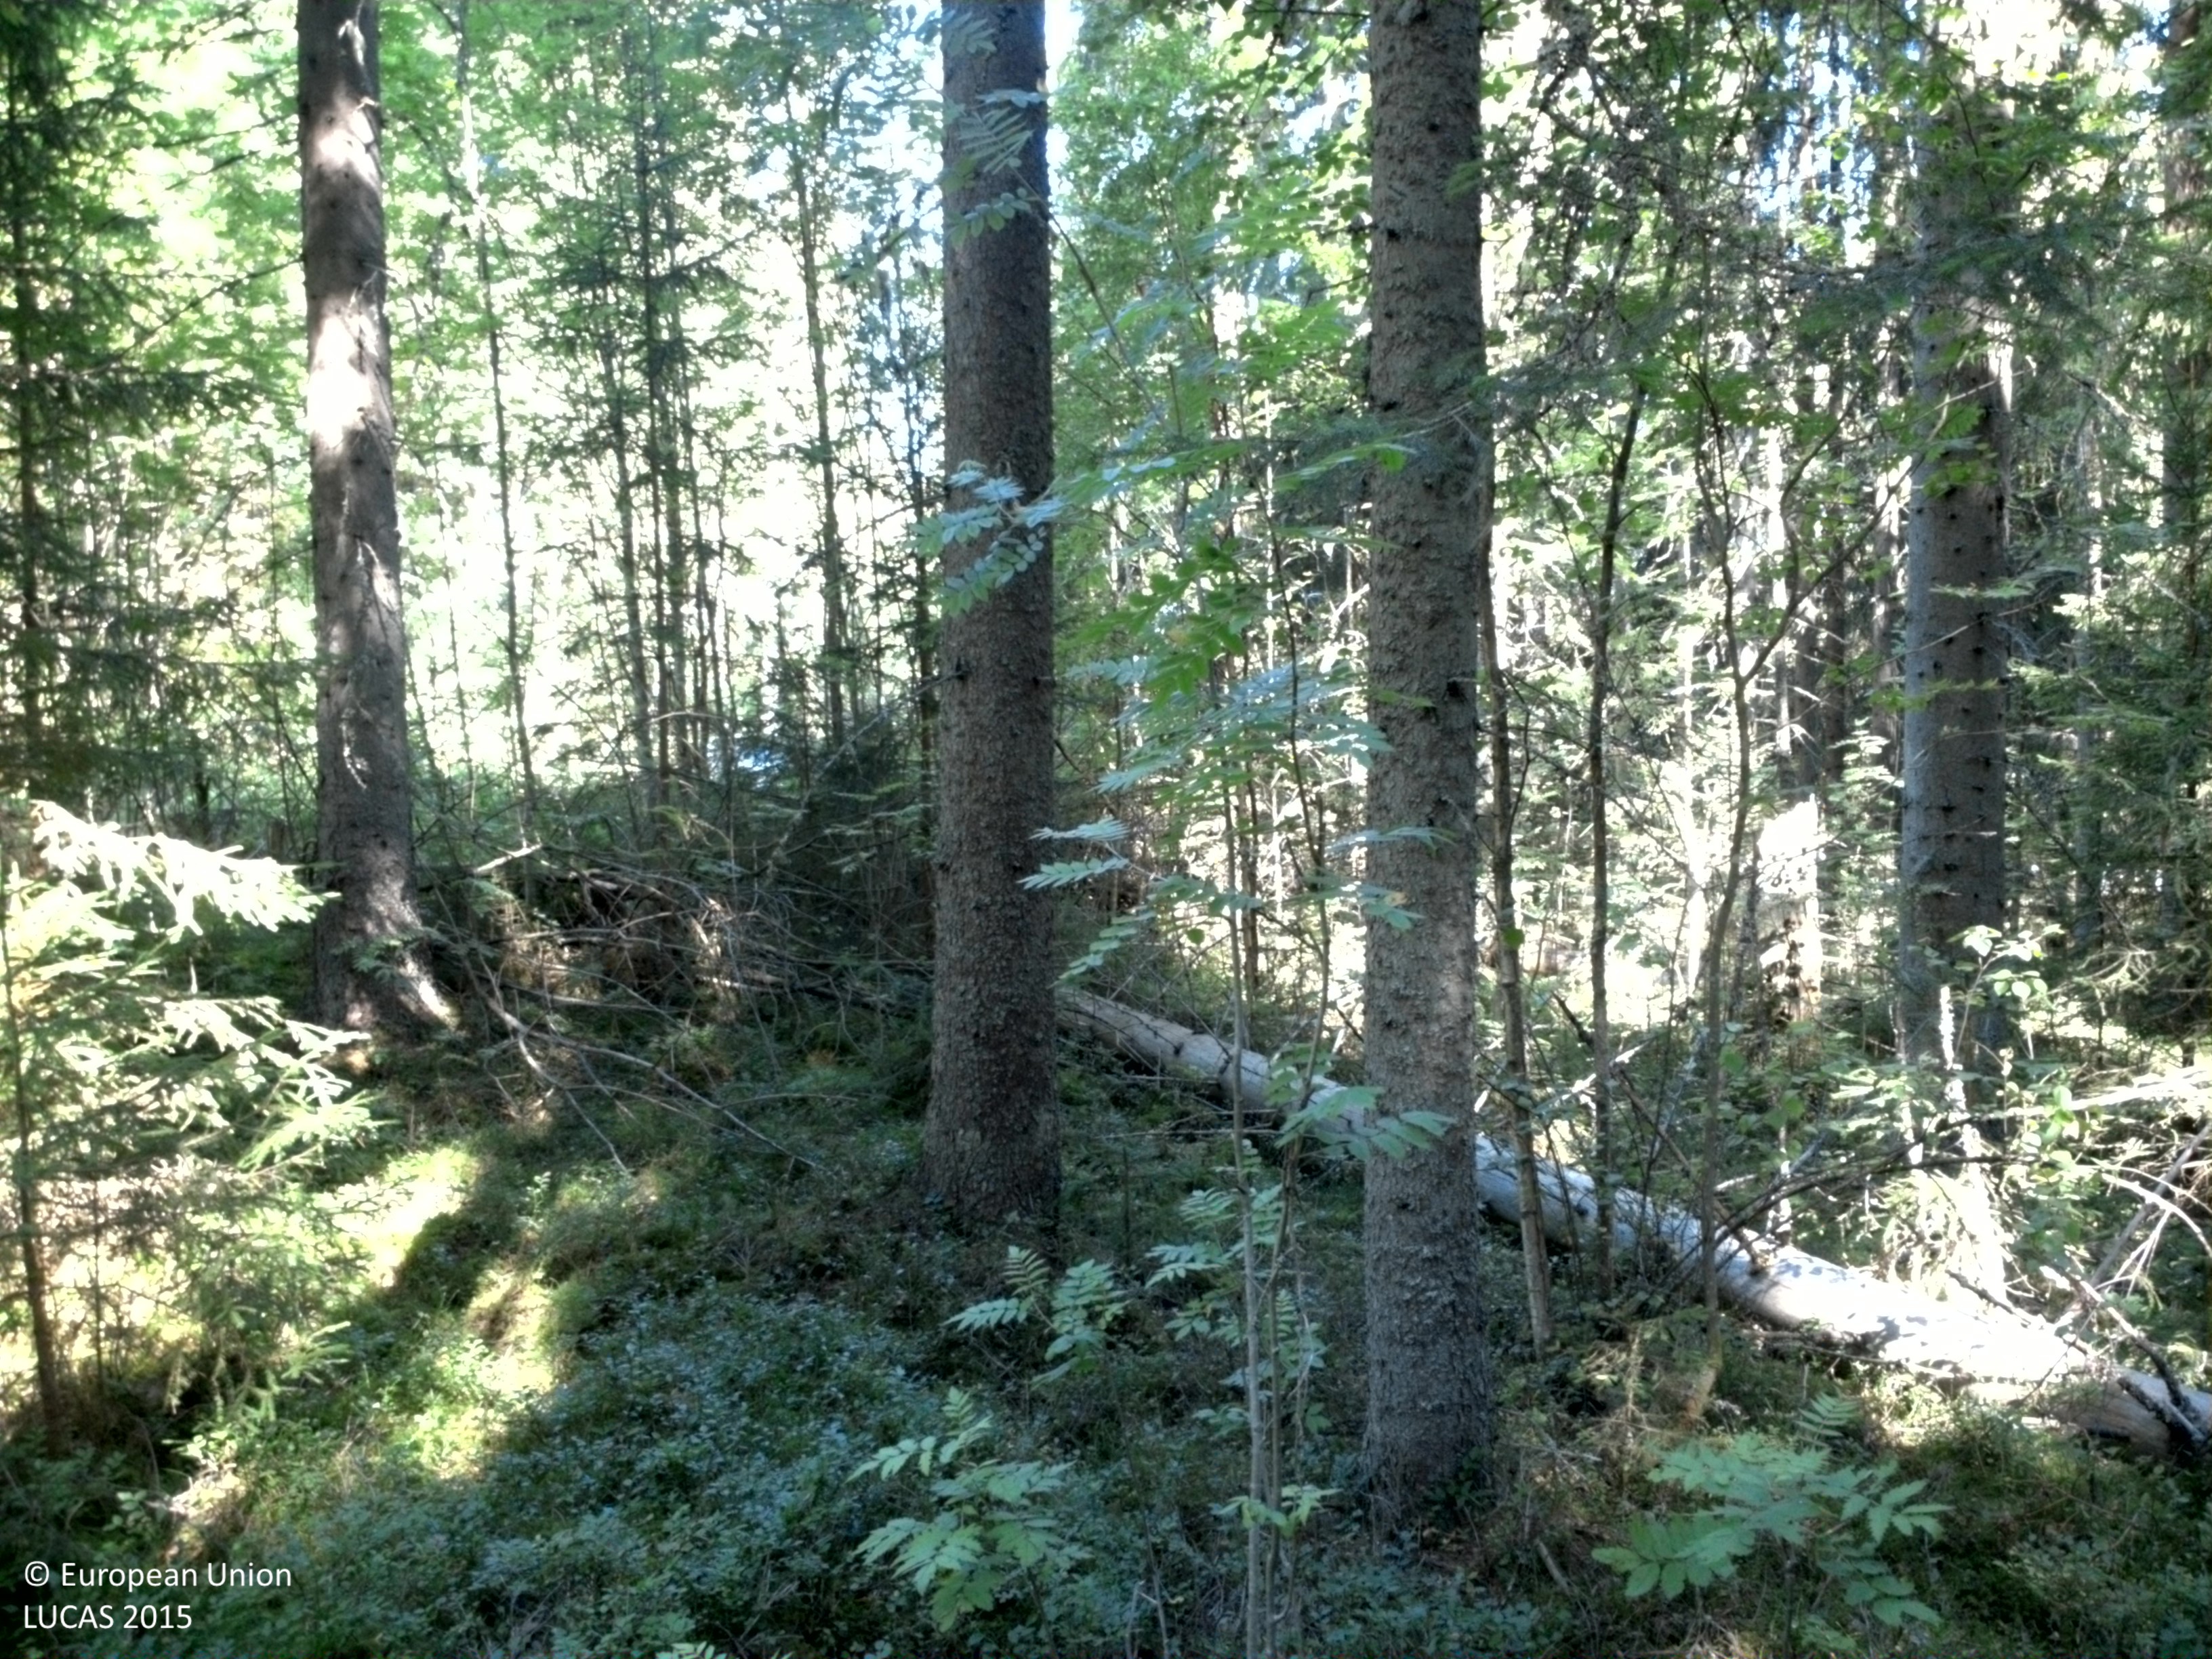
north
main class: Woodland
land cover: Spruce dominated coniferous woodland
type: boreal forest
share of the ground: 50 - 75 %
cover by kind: coniferous forest trees 65 %, lichens and mosses 20 %, broadleaved forest trees 5 %, shrubs 5 %, herbaceous plants 5 %
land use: Forestry
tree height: > 5 m
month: August
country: SE
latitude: 60.1183
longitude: 13.5354
